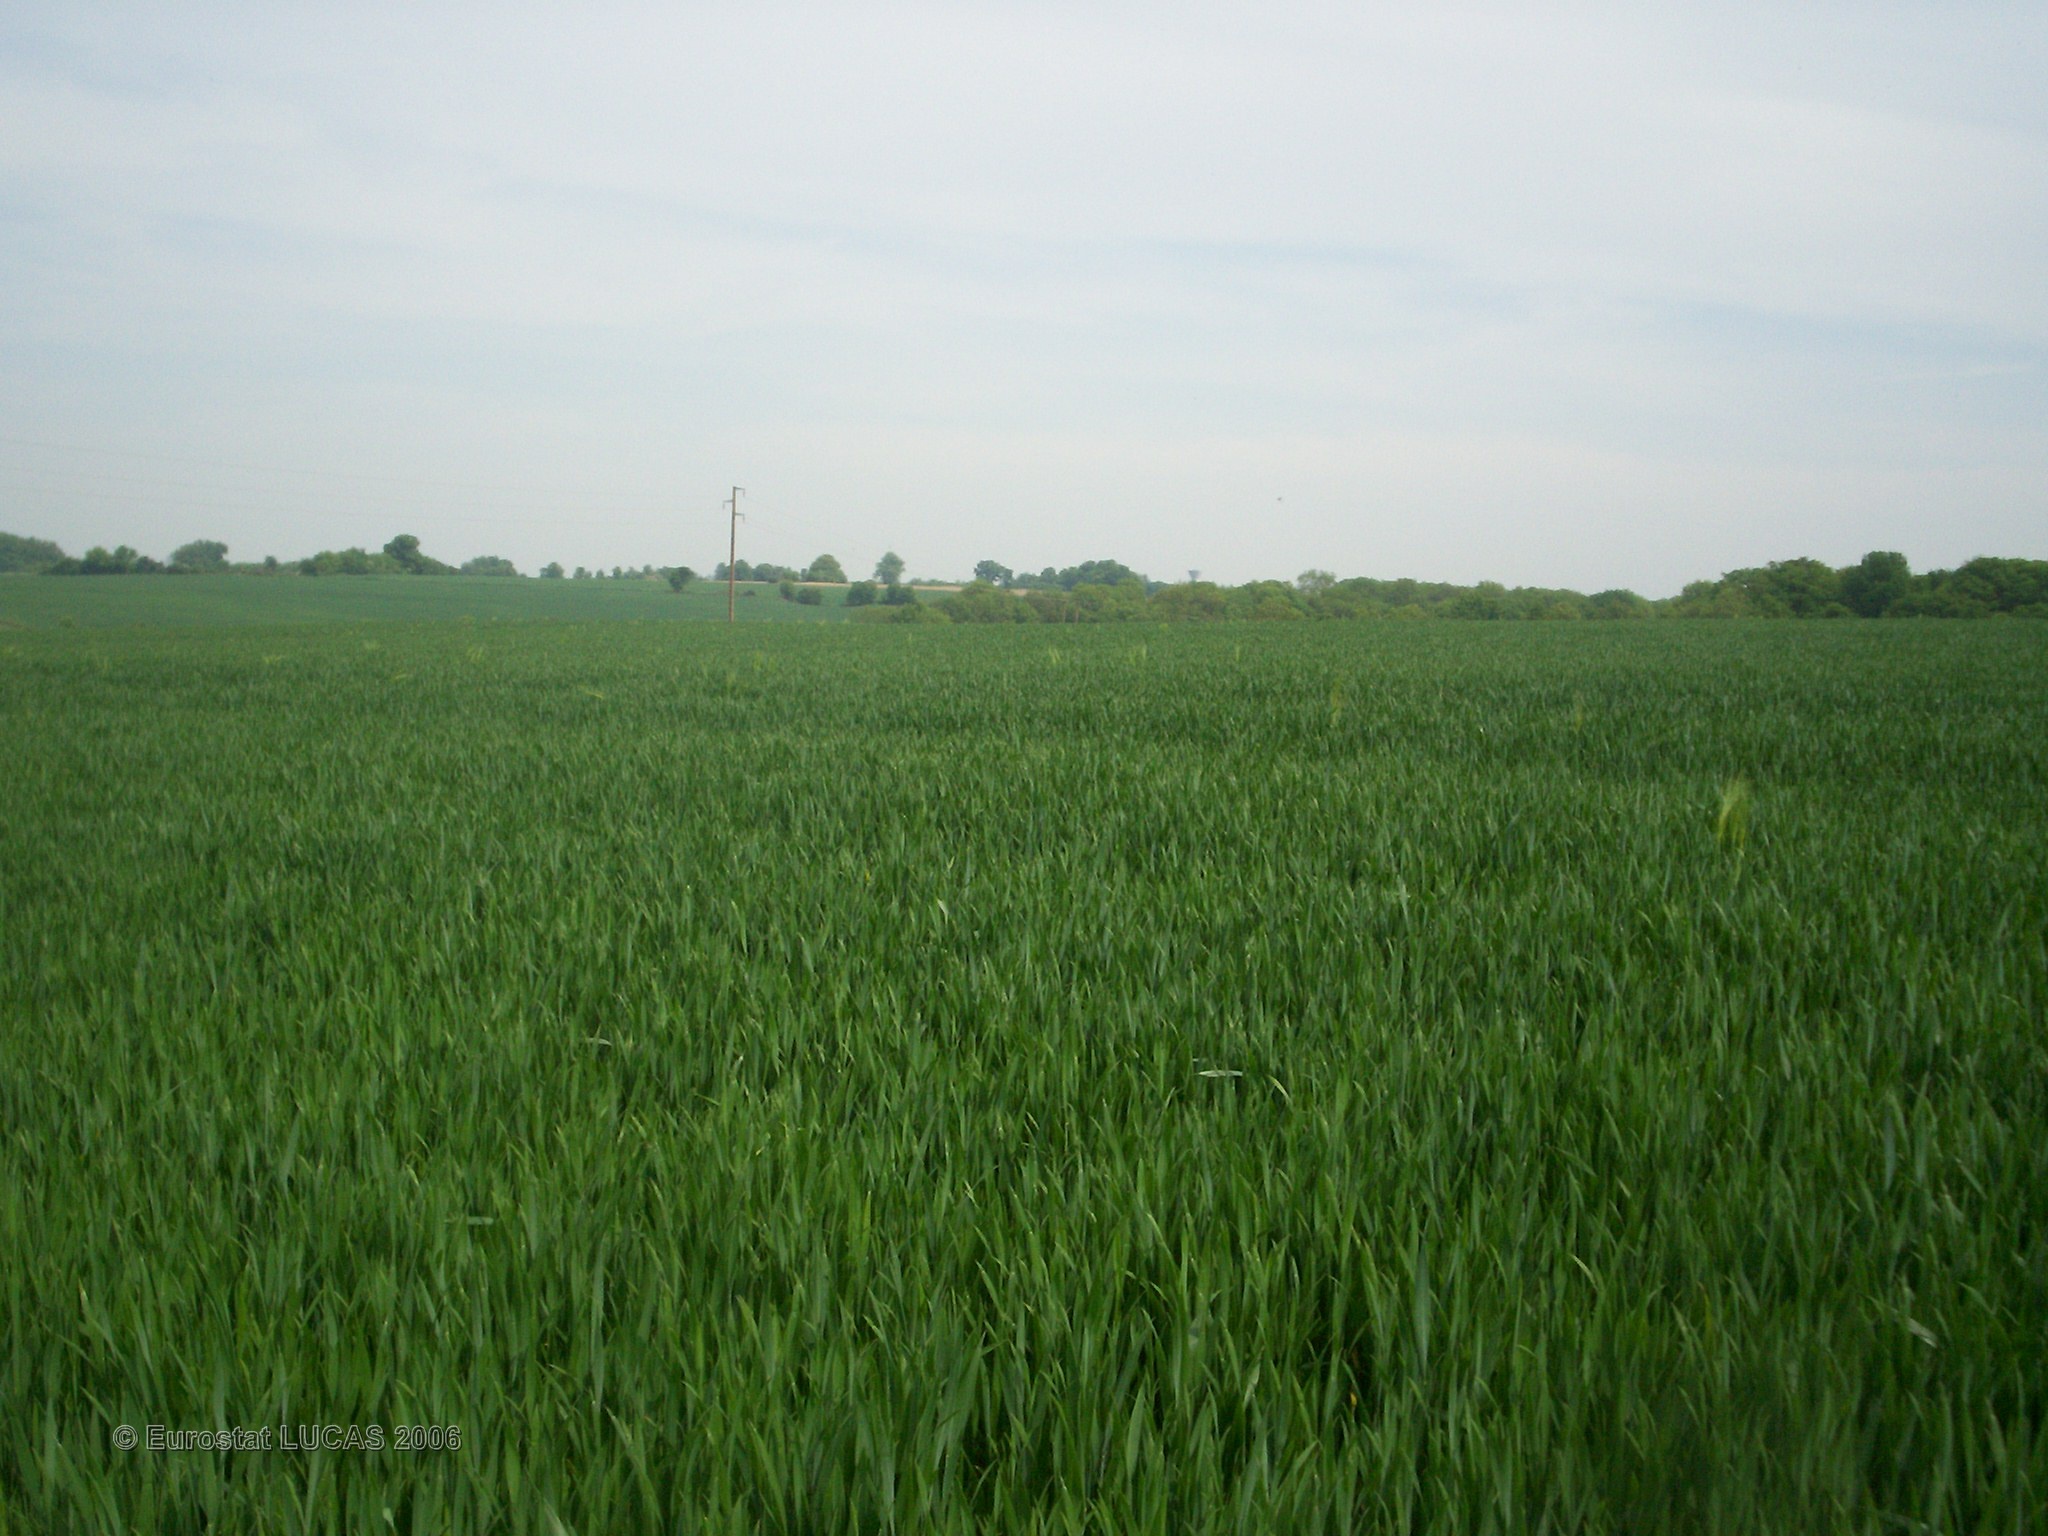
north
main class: Cropland
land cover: Common wheat
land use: Agriculture (excluding fallow land and kitchen gardens)
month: May
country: FR
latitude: 47.7279
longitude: 2.9671
